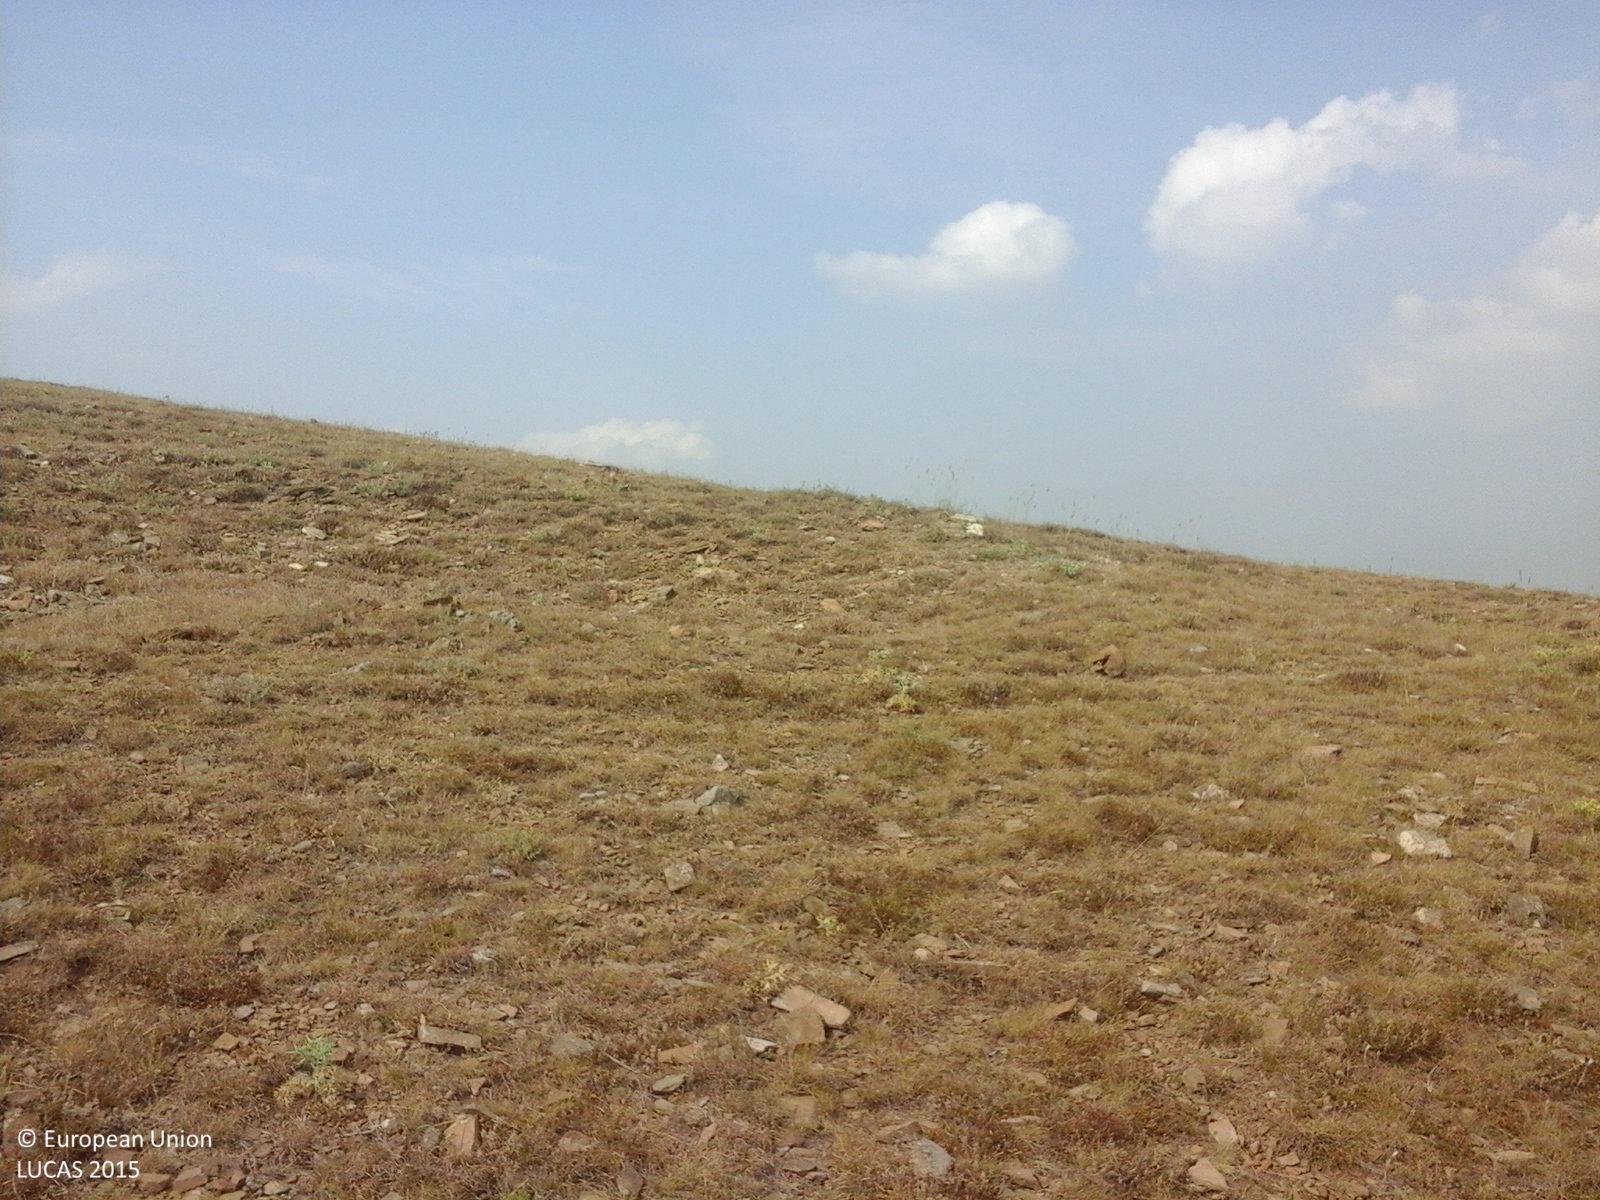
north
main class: Grassland
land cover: Grassland without tree/shrub cover
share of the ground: > 75 %
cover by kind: herbaceous plants 80 %, unconsolidated bare surface 20 %
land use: Agriculture (excluding fallow land and kitchen gardens)
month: July
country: RO
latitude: 45.0901
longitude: 28.4893
